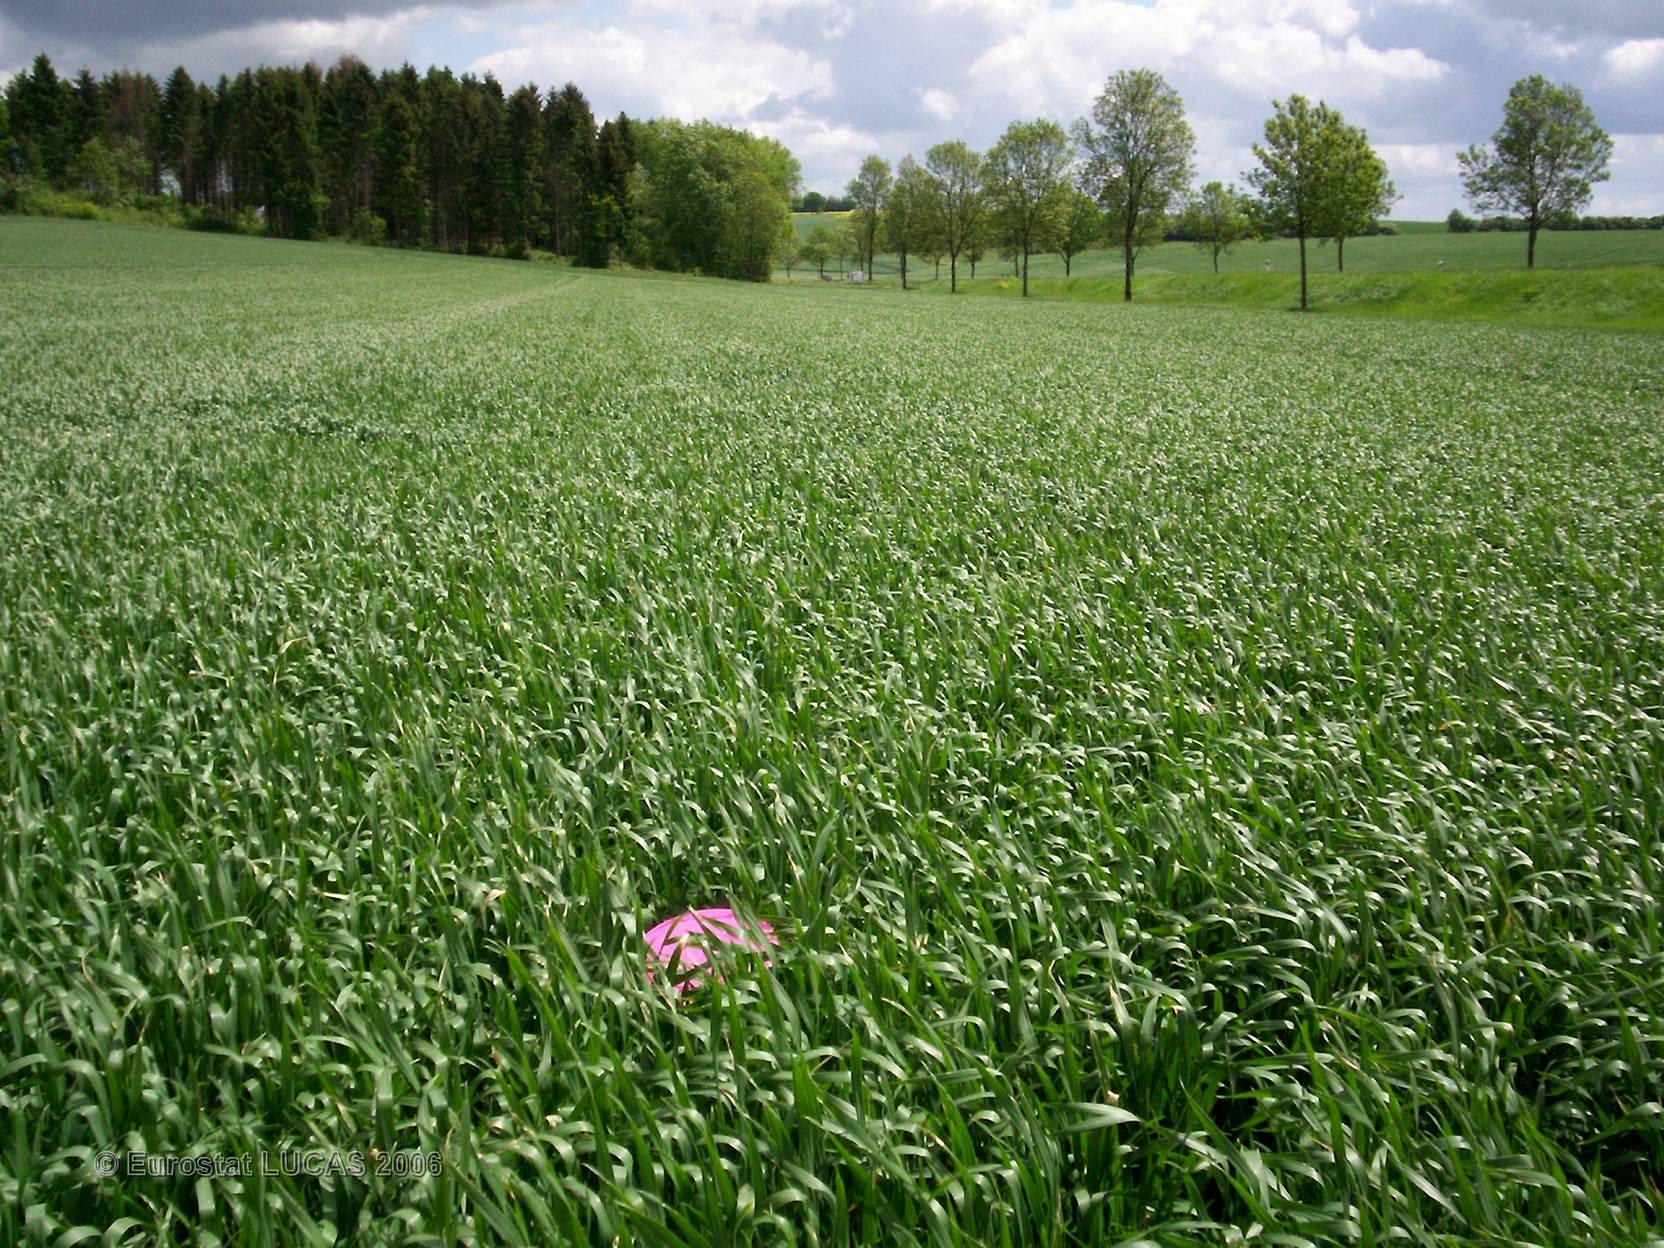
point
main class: Cropland
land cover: Common wheat
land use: Agriculture (excluding fallow land and kitchen gardens)
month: May
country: FR
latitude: 49.3526
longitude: 5.8554
